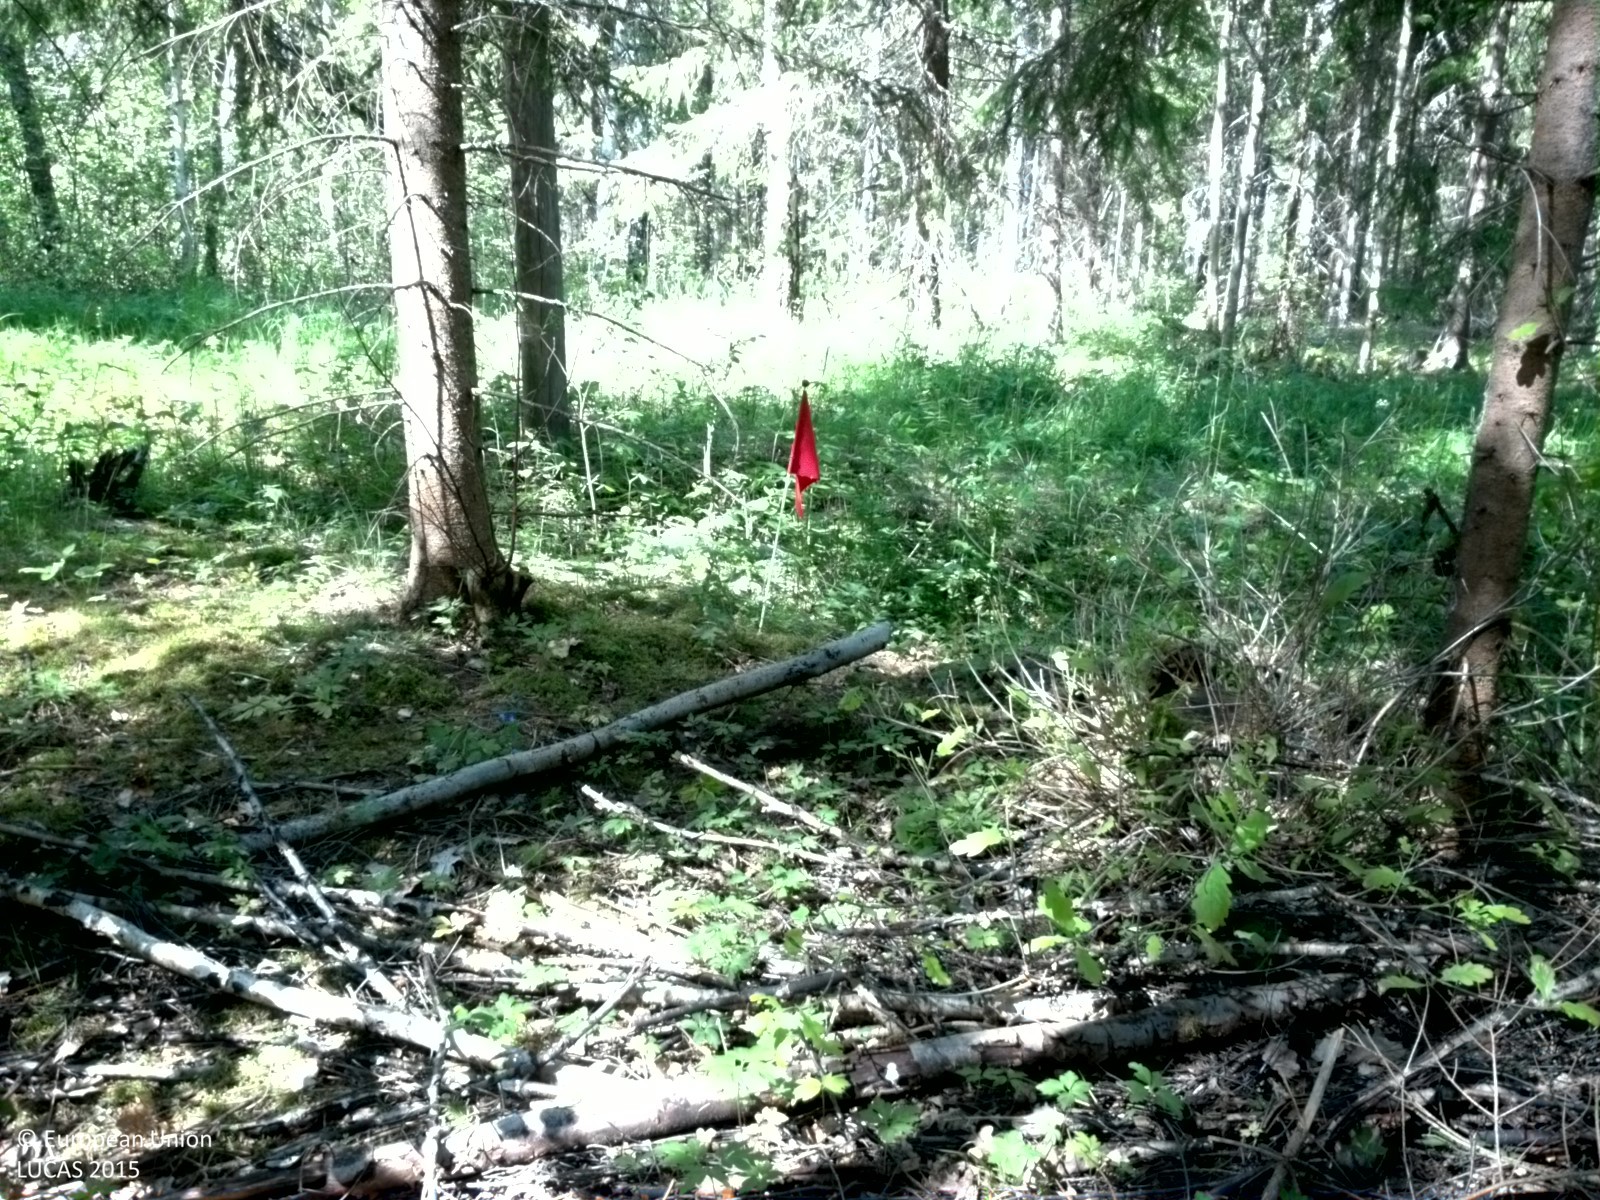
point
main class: Woodland
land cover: Spruce dominated coniferous woodland
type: boreal forest
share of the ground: 50 - 75 %
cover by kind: coniferous forest trees 50 %, herbaceous plants 30 %, broadleaved forest trees 10 %, shrubs 10 %
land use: Forestry
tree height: > 5 m
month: June
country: SE
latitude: 60.1897
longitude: 17.6571
